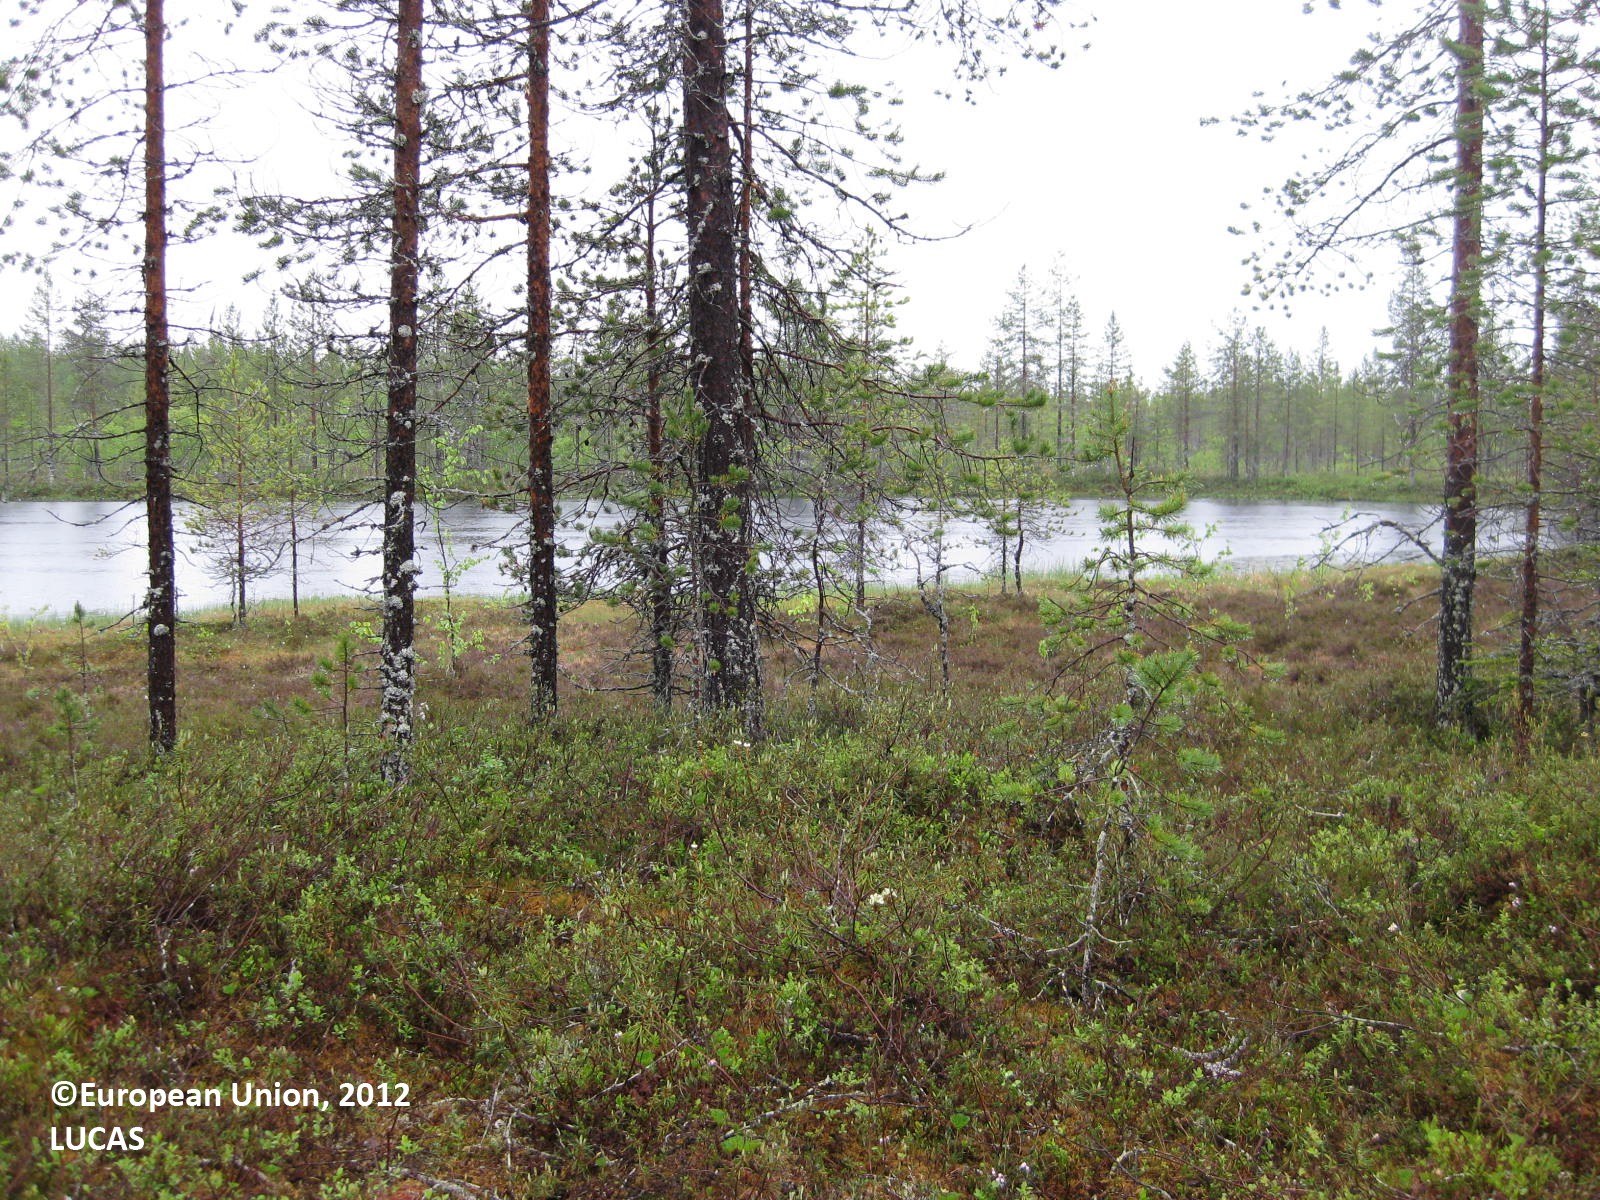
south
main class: Woodland
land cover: Pine dominated mixed woodland
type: boreal forest
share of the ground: 50 - 75 %
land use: Forestry
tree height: > 5 m
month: June
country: FI
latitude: 65.2758
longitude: 28.9740
